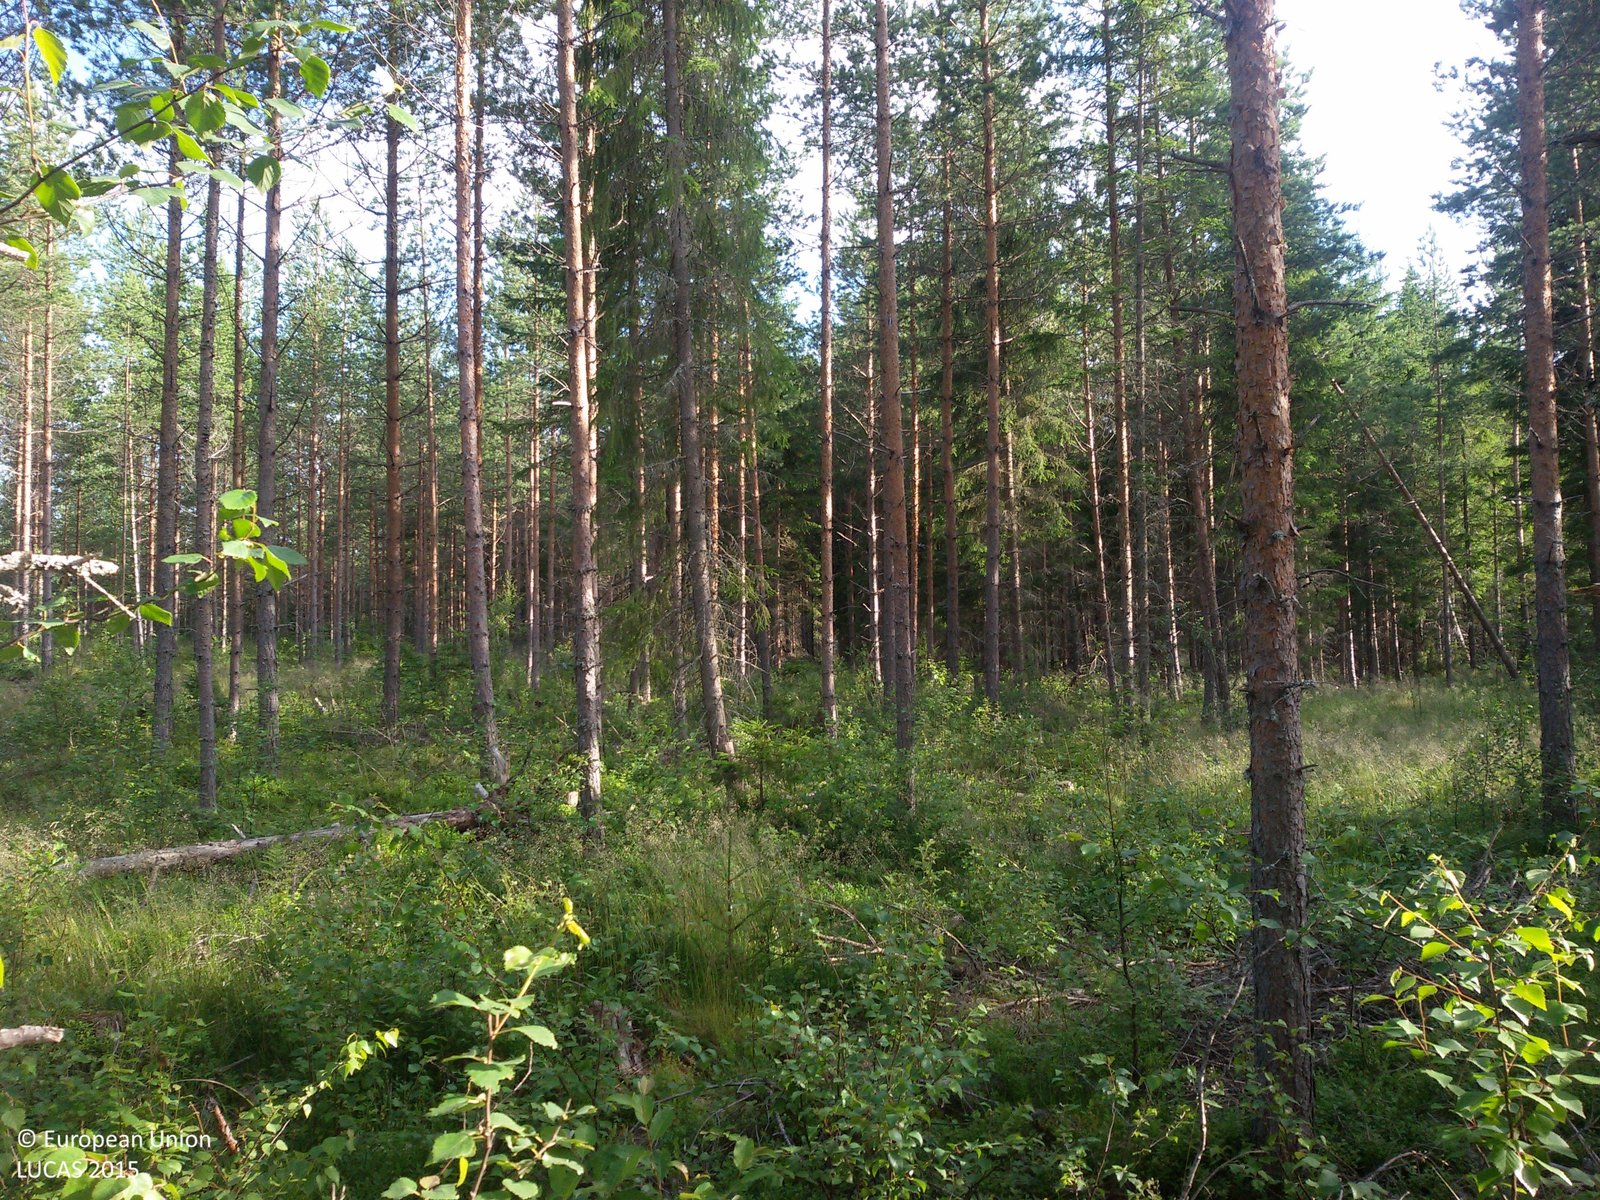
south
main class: Woodland
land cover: Pine dominated coniferous woodland
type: boreal forest
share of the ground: 50 - 75 %
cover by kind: coniferous forest trees 50 %, shrubs 30 %, broadleaved forest trees 10 %, lichens and mosses 10 %
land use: Forestry
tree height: > 5 m
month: July
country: SE
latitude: 60.5147
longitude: 15.2879
